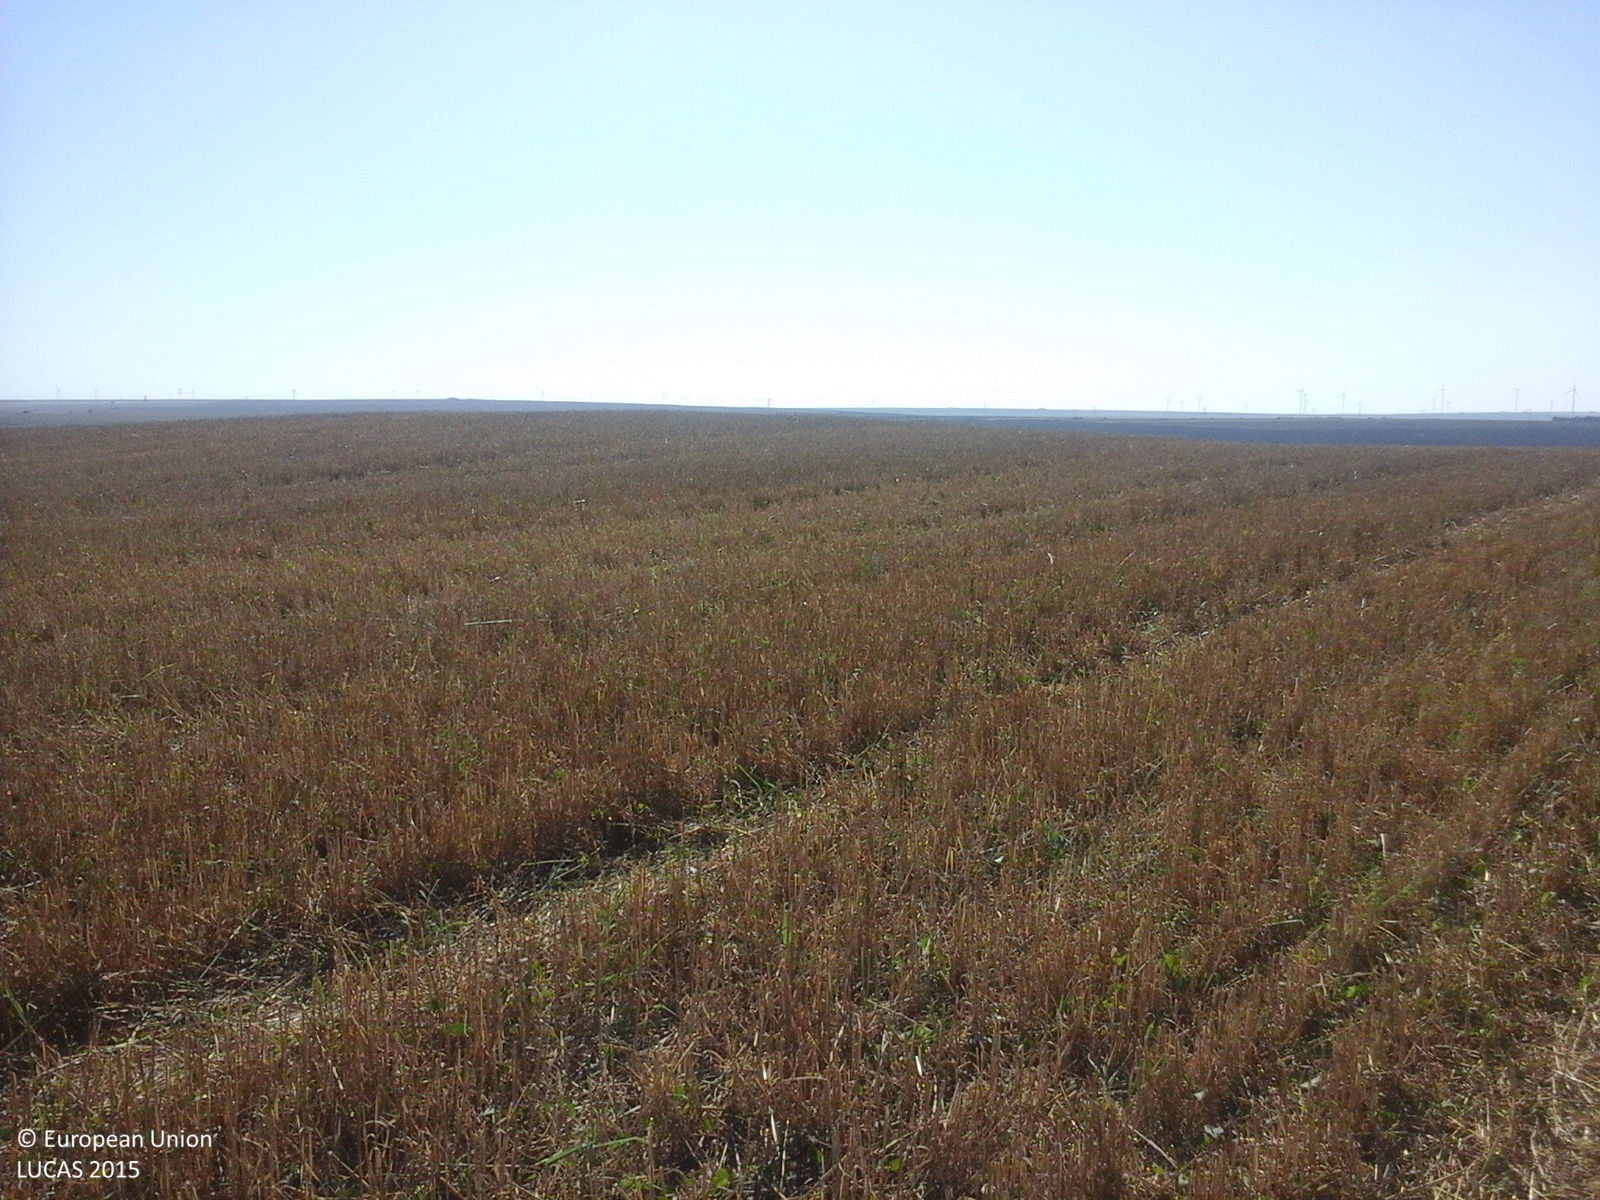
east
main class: Cropland
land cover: Common wheat
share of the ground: > 75 %
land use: Agriculture (excluding fallow land and kitchen gardens)
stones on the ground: < 10 %
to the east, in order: Common wheat
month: August
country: RO
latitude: 44.6508
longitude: 28.1583
